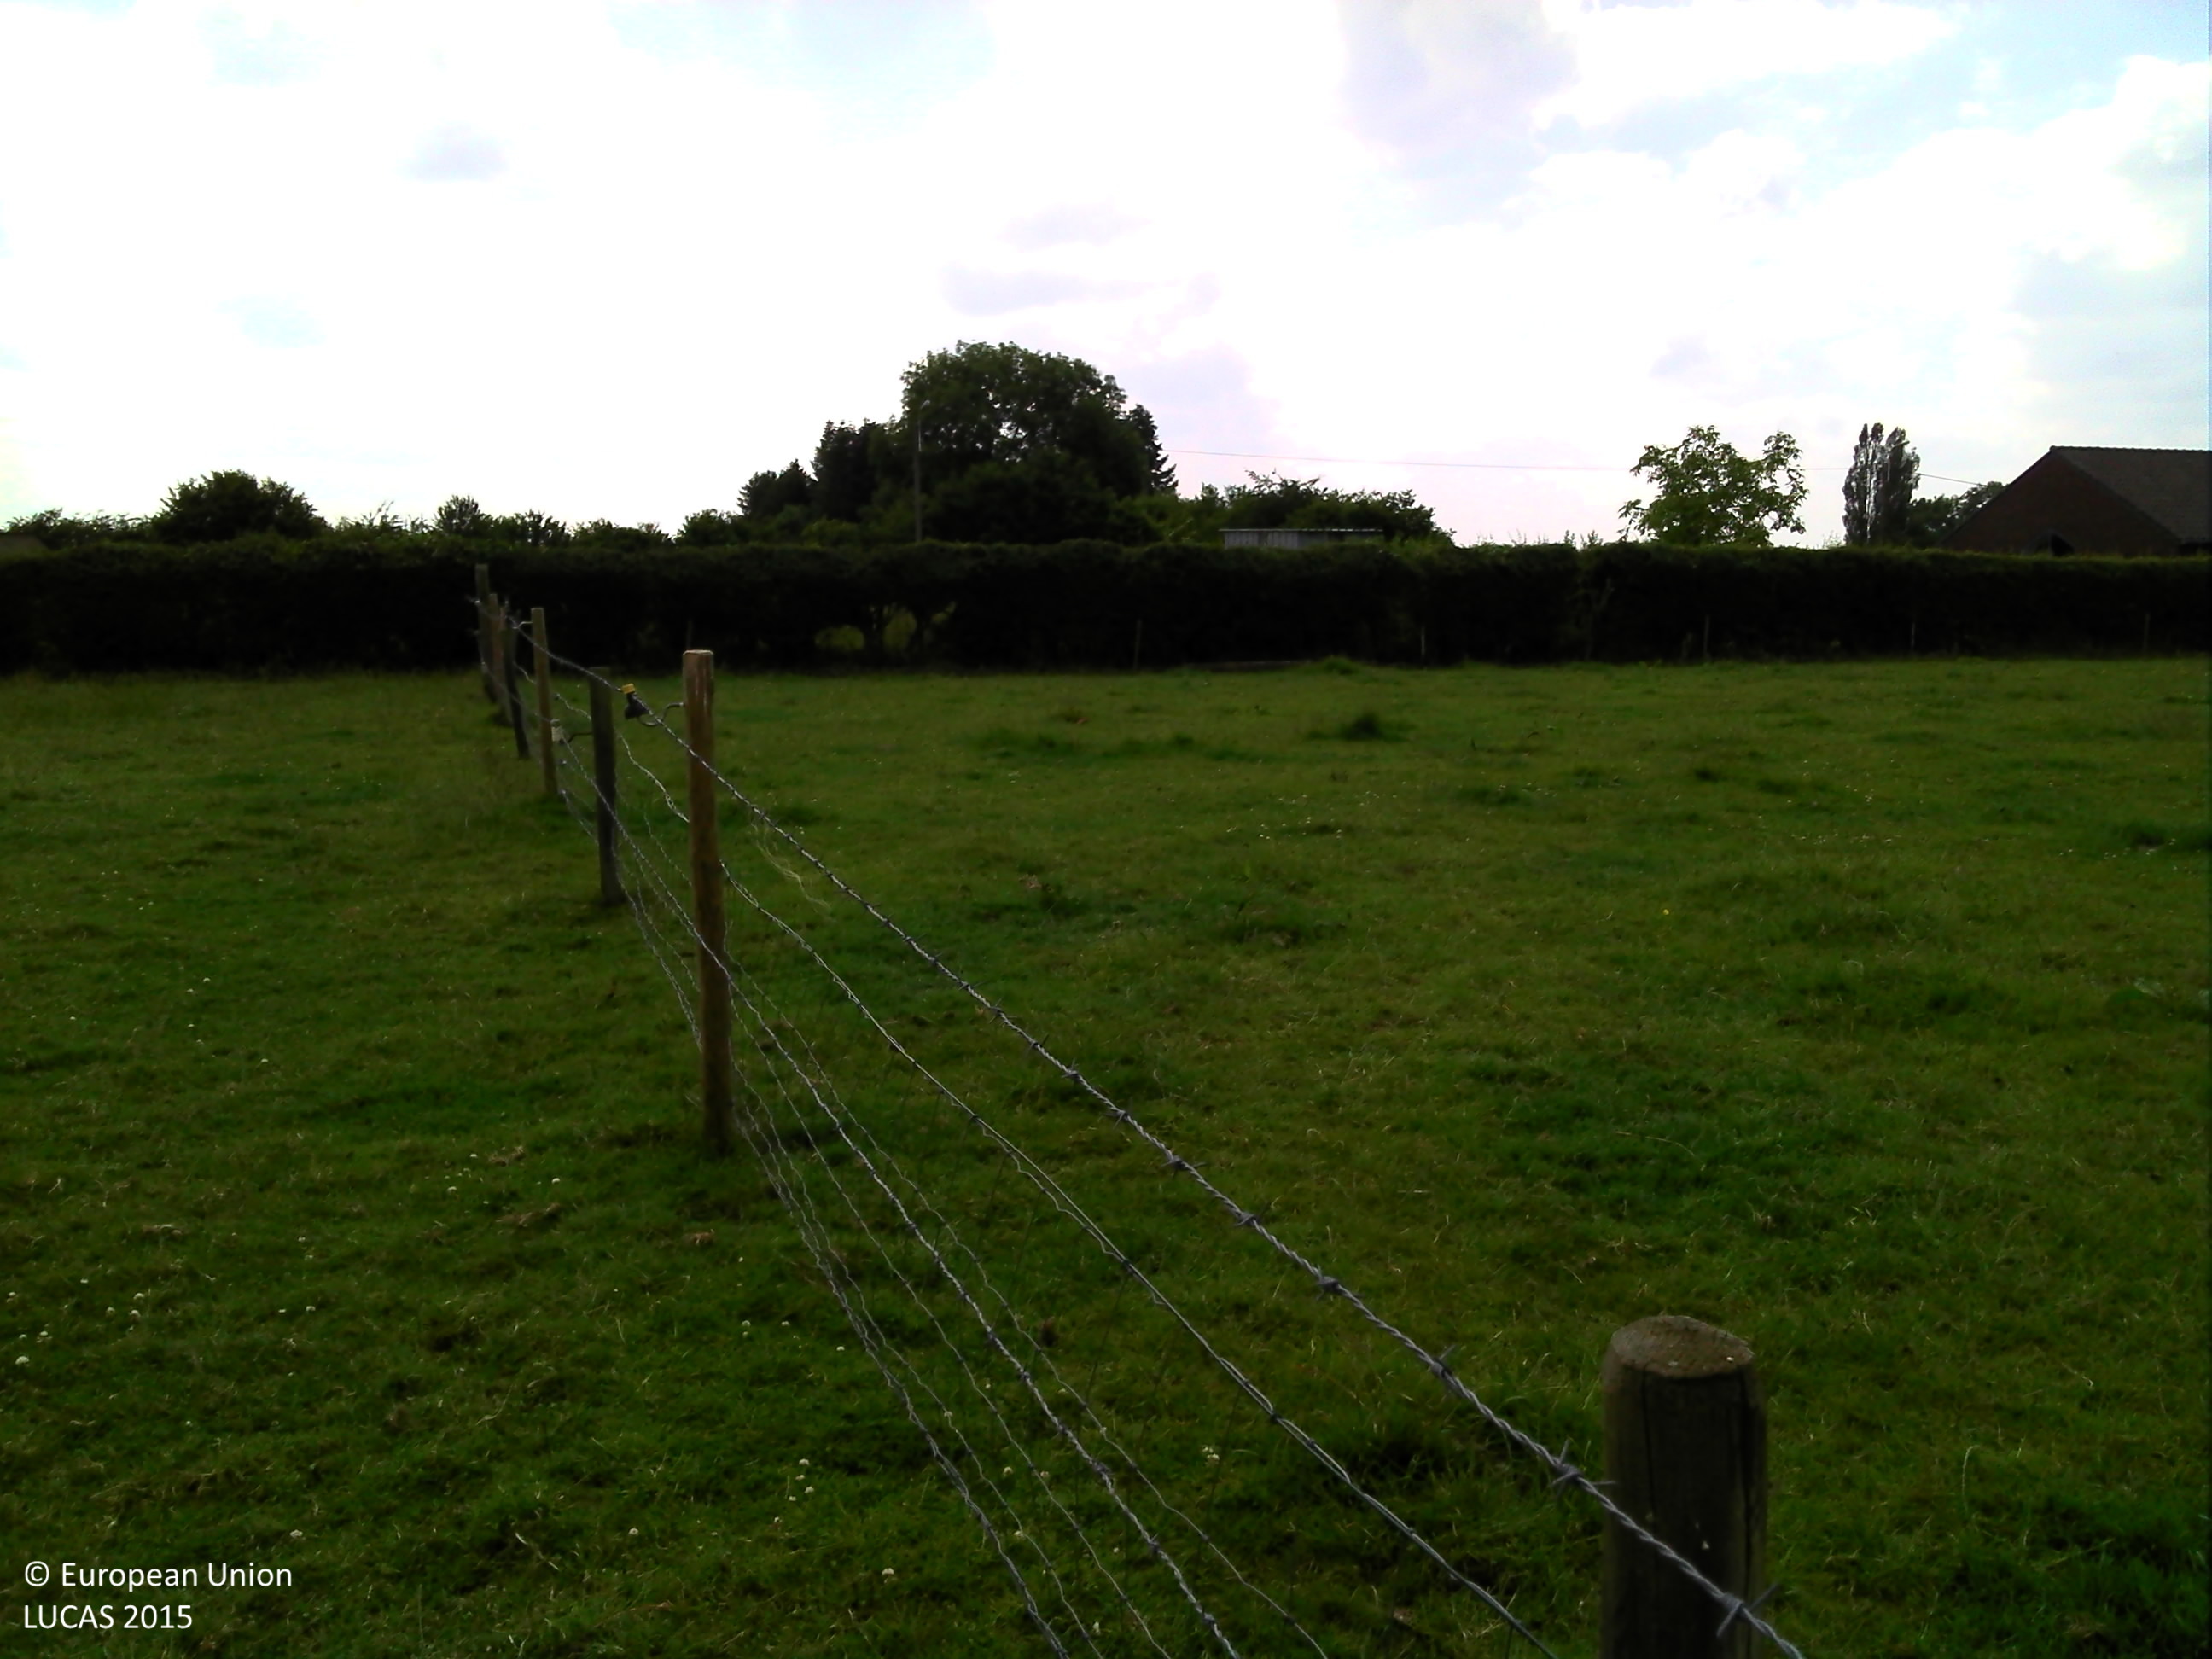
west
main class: Grassland
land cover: Grassland without tree/shrub cover
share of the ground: > 75 %
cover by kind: herbaceous plants 100 %
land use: Agriculture (excluding fallow land and kitchen gardens)
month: June
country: BE
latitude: 50.4368
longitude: 5.4787
